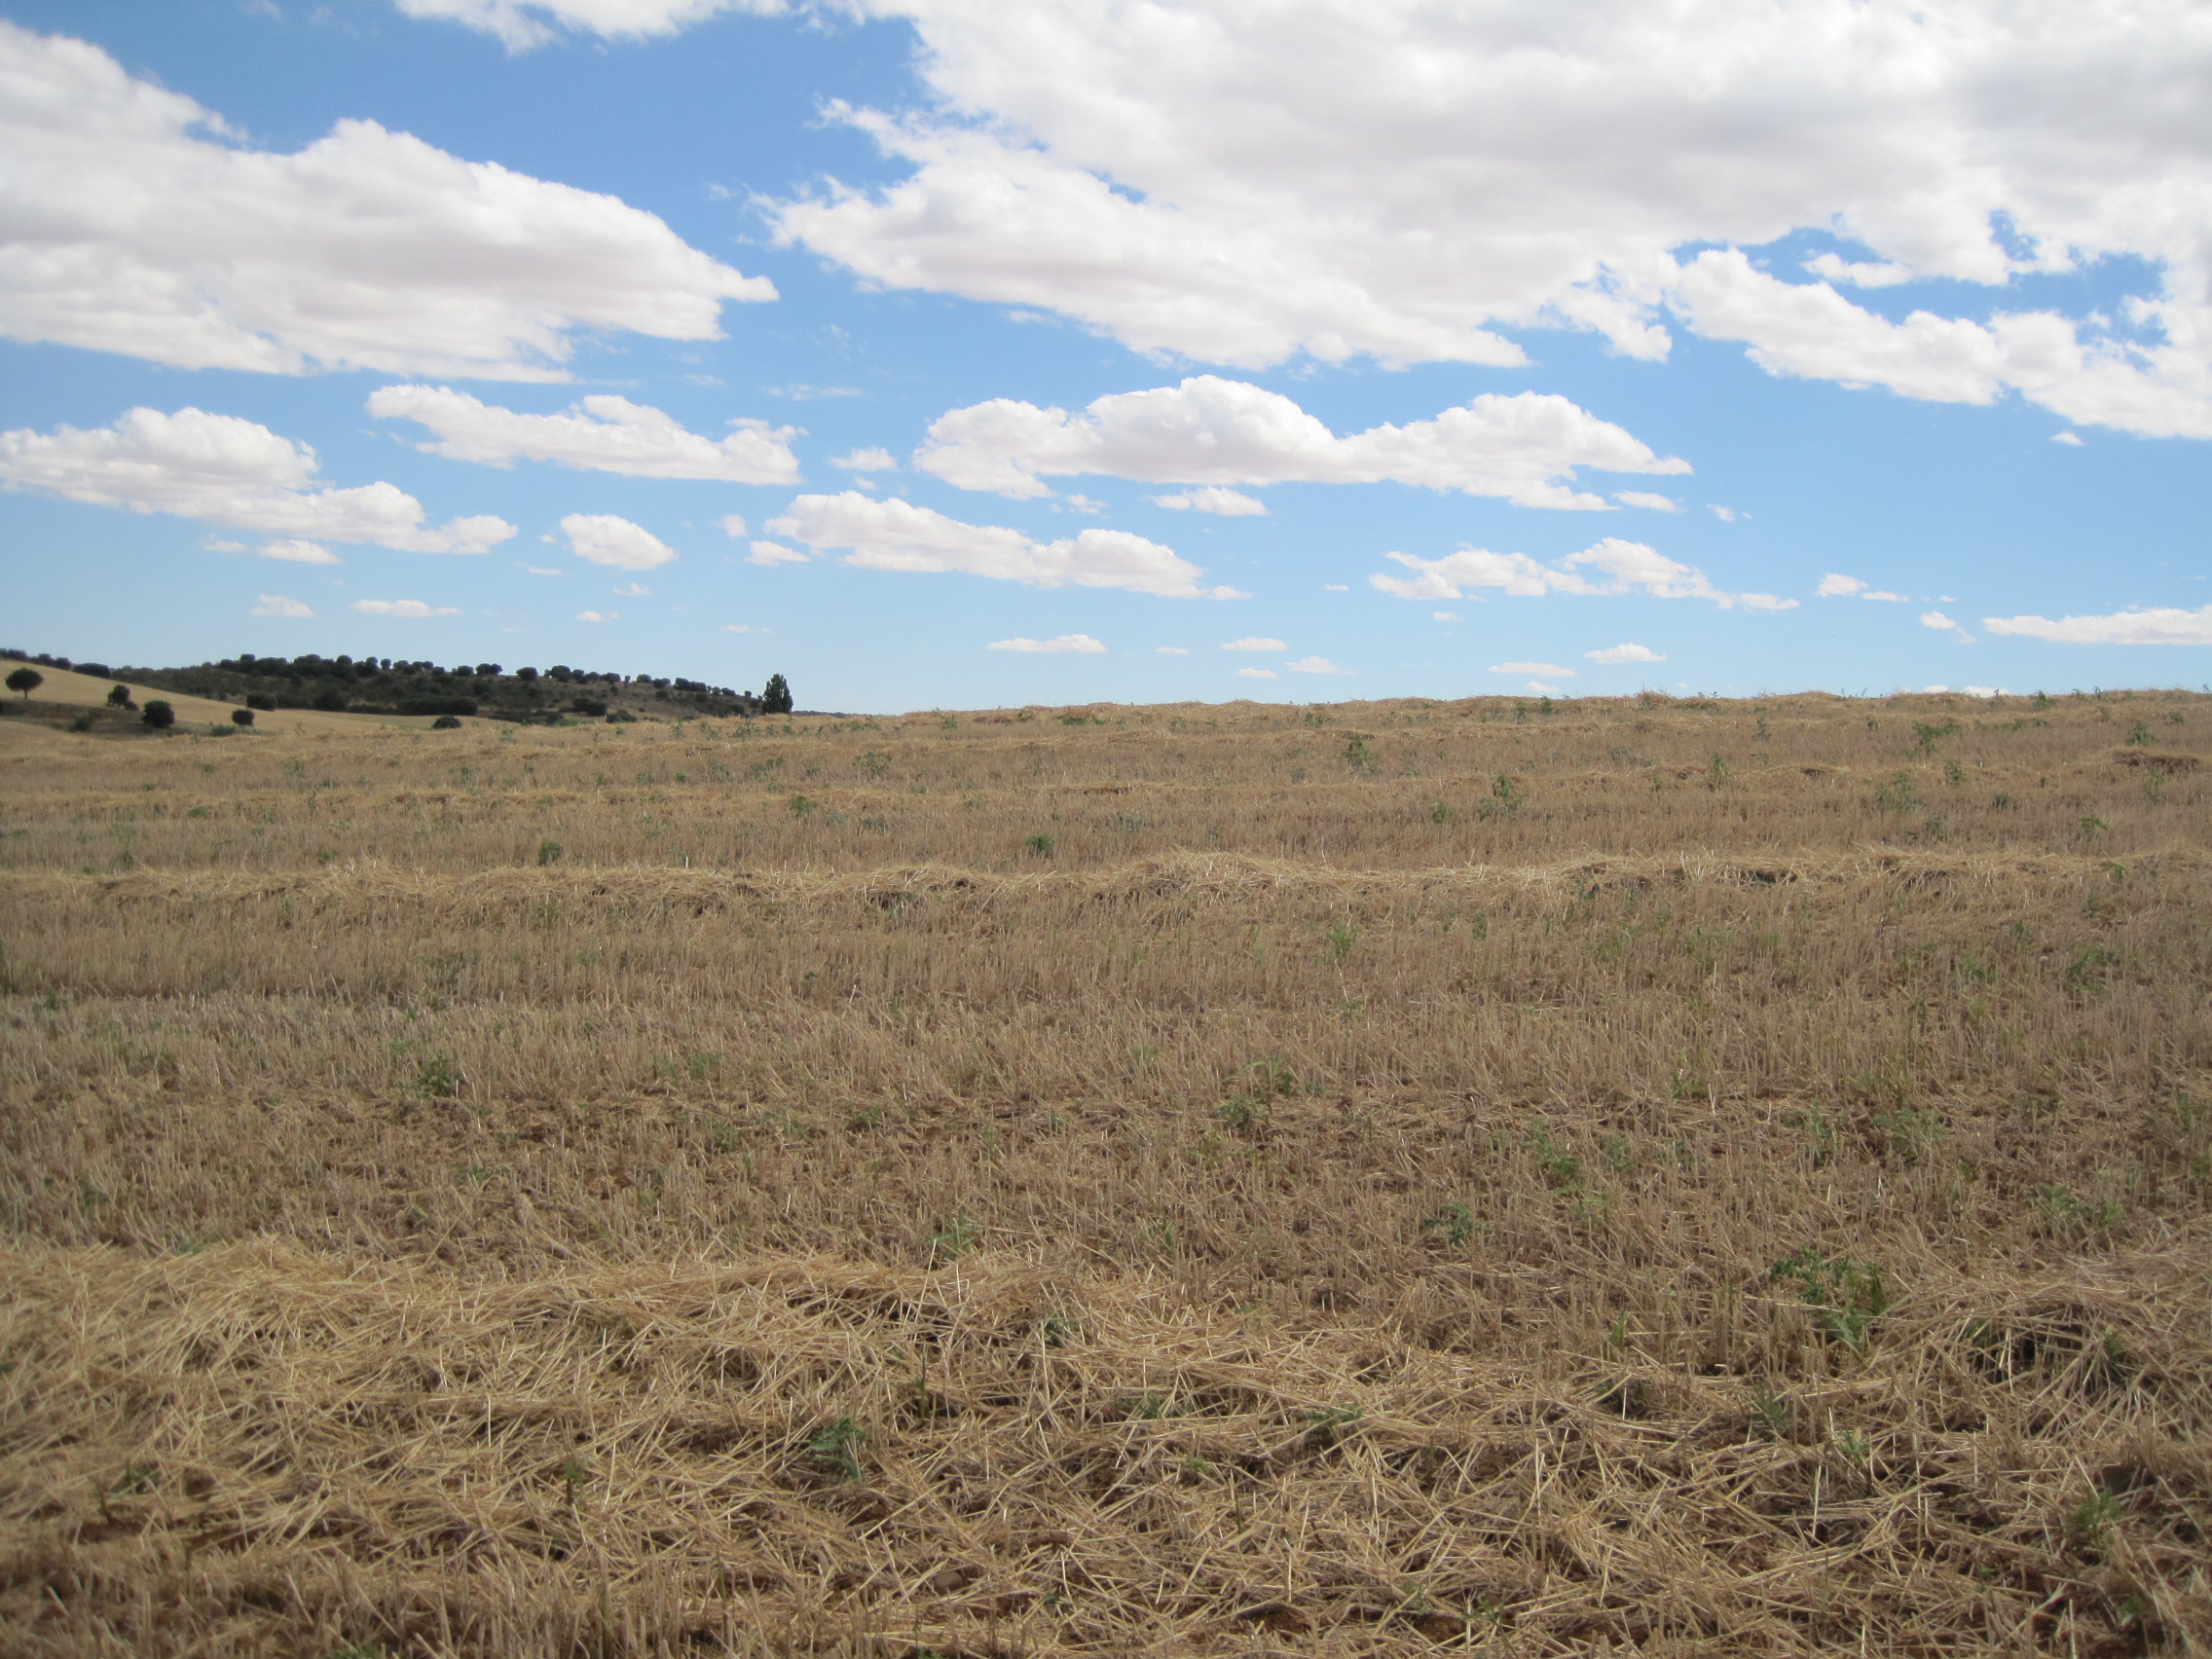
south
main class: Cropland
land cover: Common wheat
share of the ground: < 10 %
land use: Agriculture (excluding fallow land and kitchen gardens)
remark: Harvested field
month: July
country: ES
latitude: 42.1331
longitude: -5.4904
